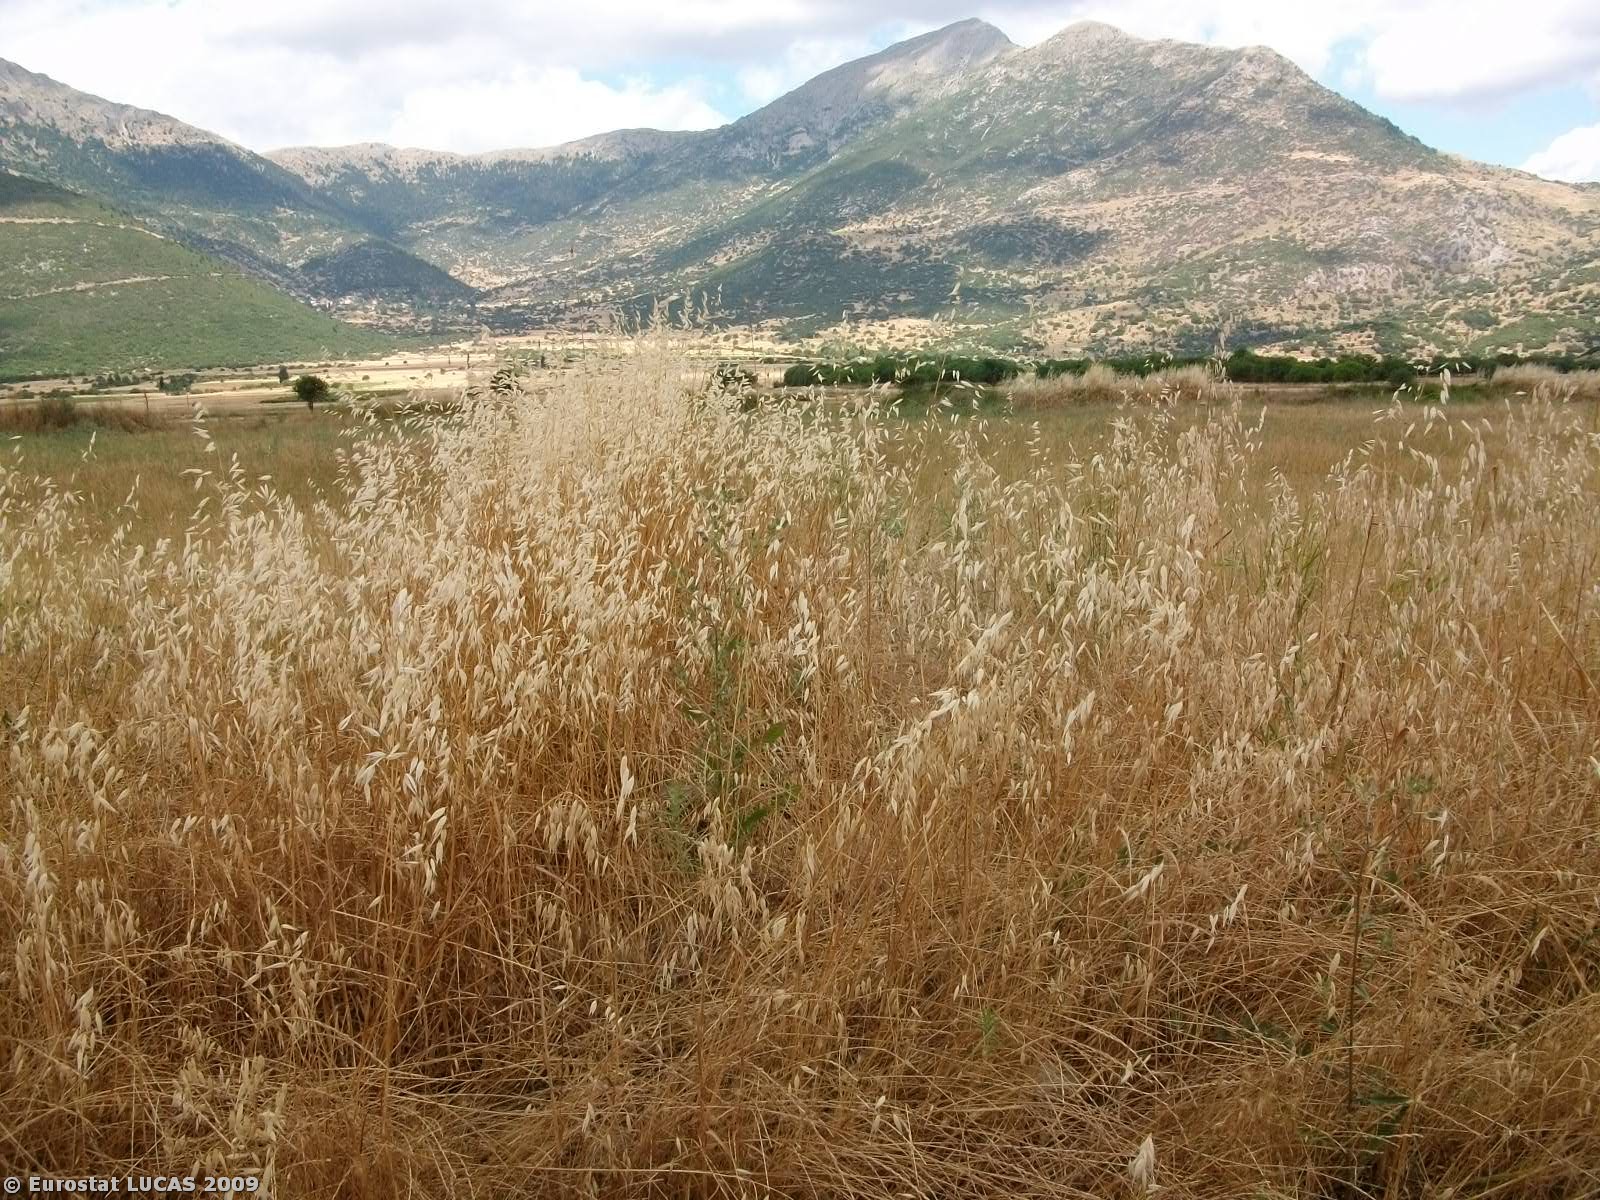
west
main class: Grassland
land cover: Spontaneously vegetated surfaces
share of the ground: > 75 %
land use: Fallow land
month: June
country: GR
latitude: 37.7490
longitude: 22.4614
